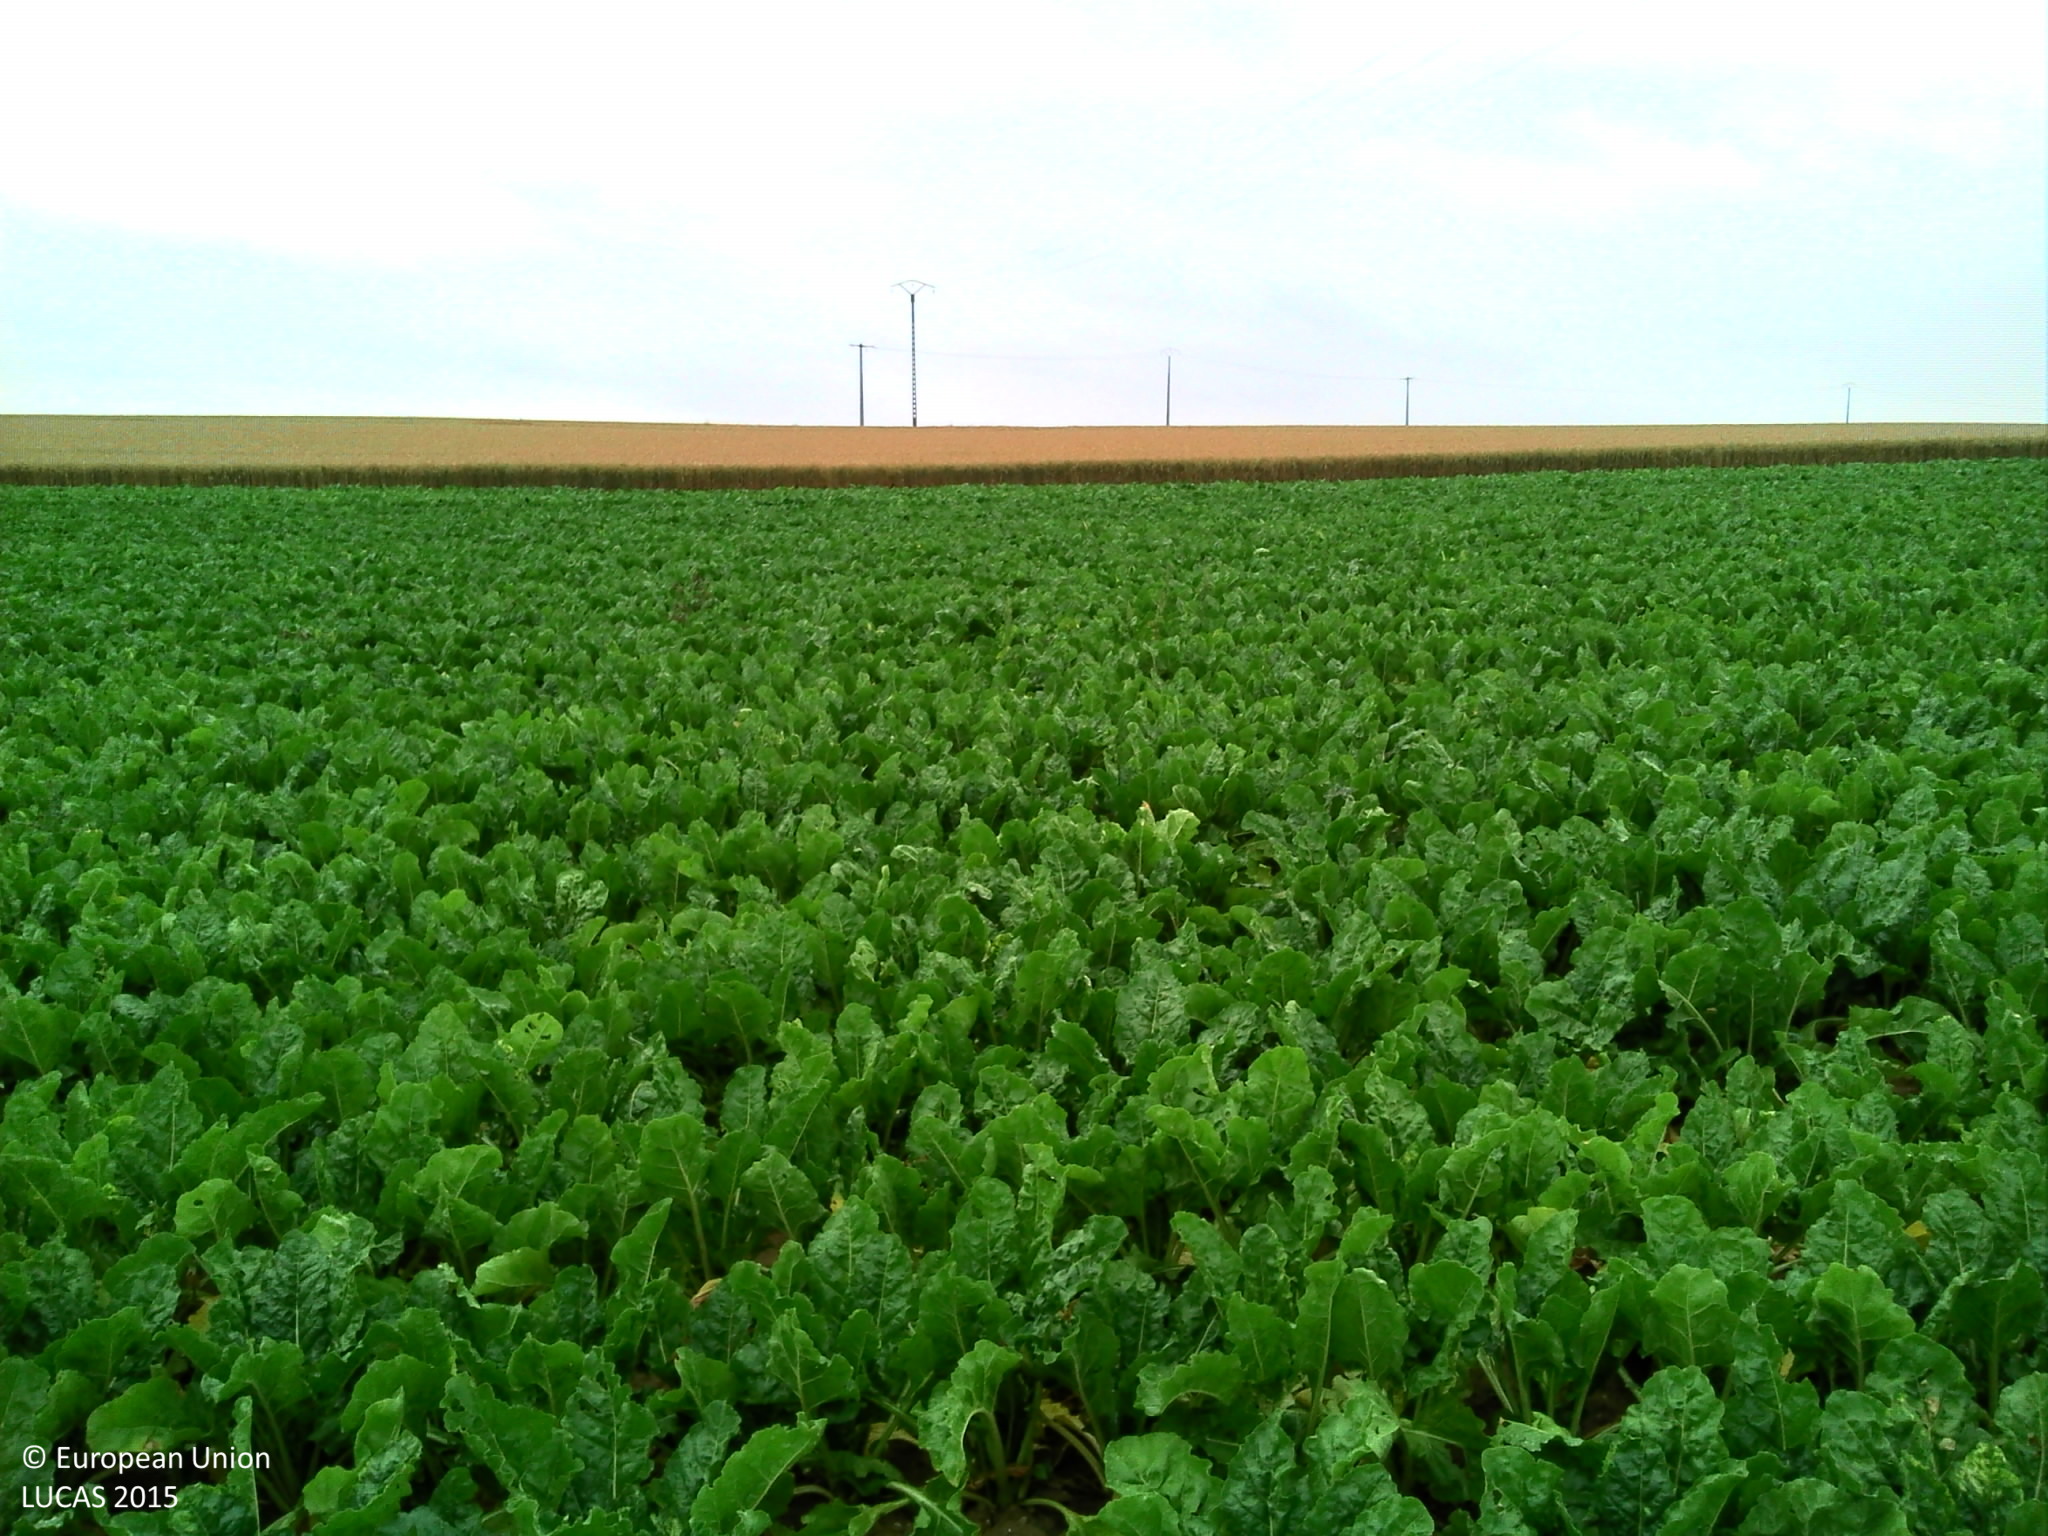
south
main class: Cropland
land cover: Sugar beet
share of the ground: > 75 %
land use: Agriculture (excluding fallow land and kitchen gardens)
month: July
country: FR
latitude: 50.1031
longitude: 3.1260
